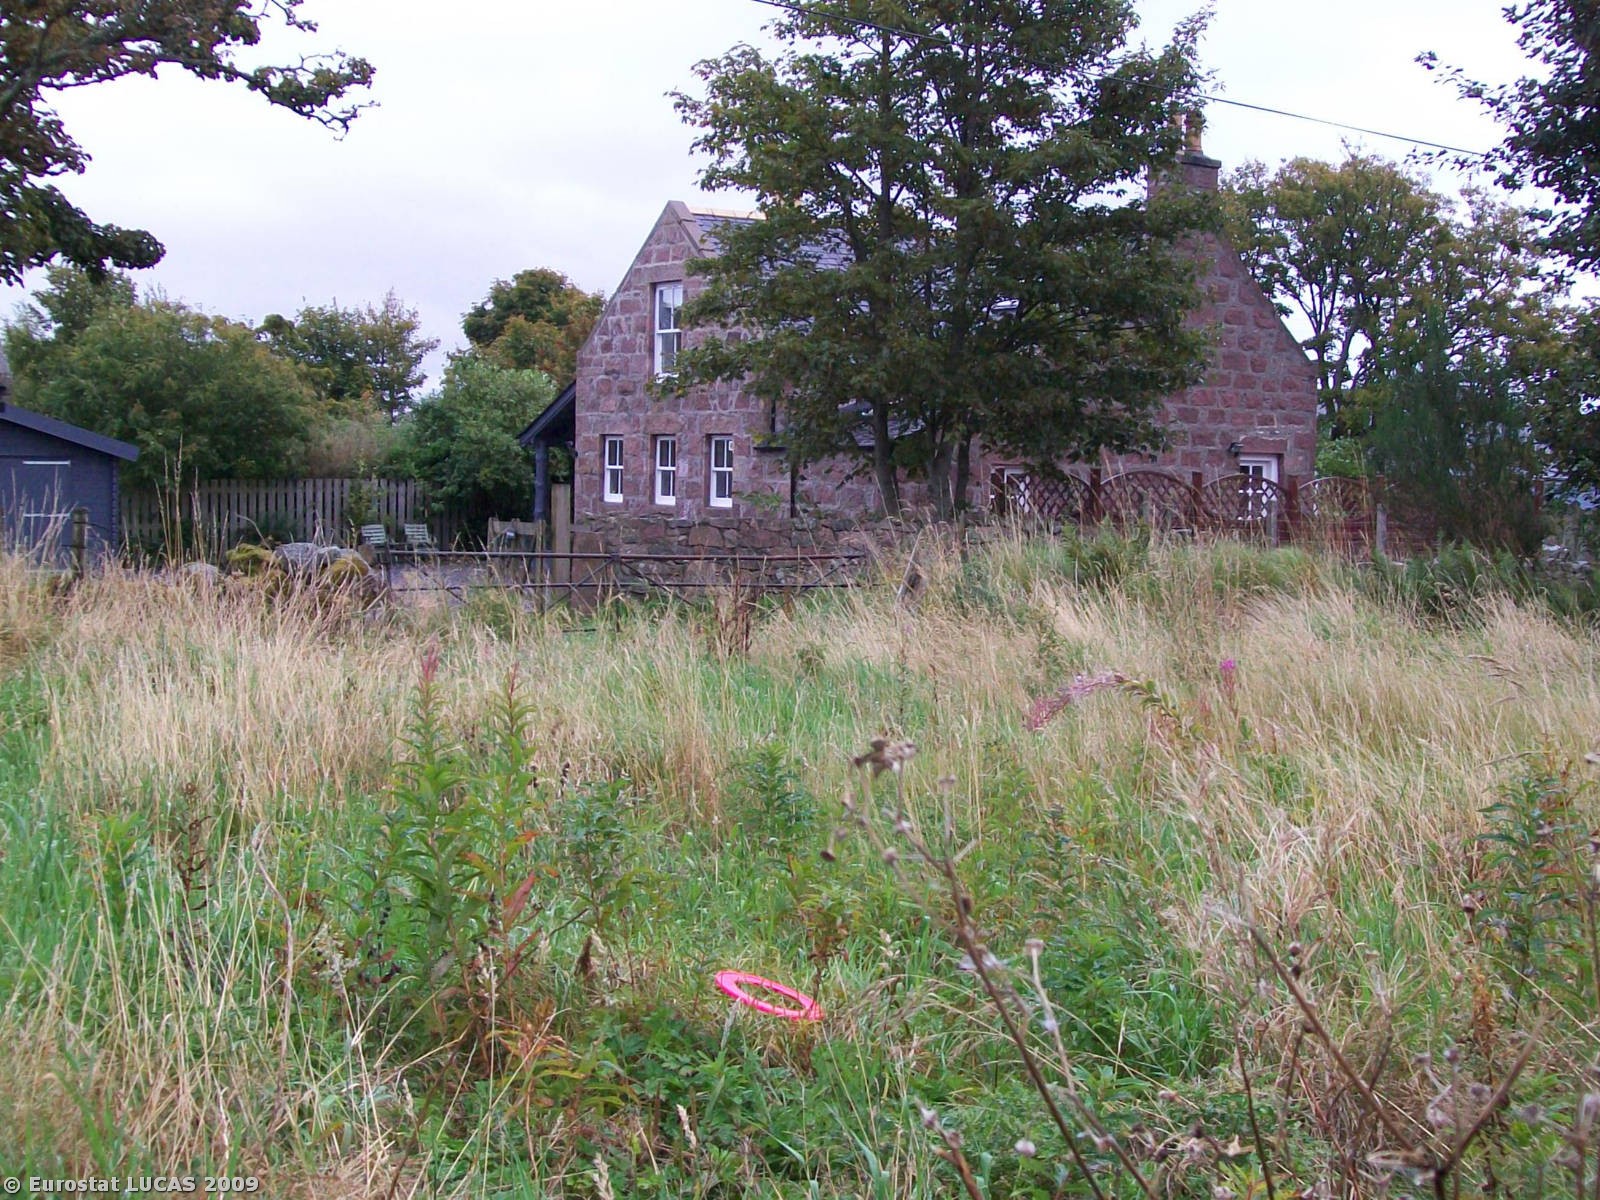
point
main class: Grassland
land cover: Grassland with sparse tree/shrub cover
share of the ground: > 75 %
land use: Fallow land
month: September
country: GB
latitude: 57.0911
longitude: -2.4476
